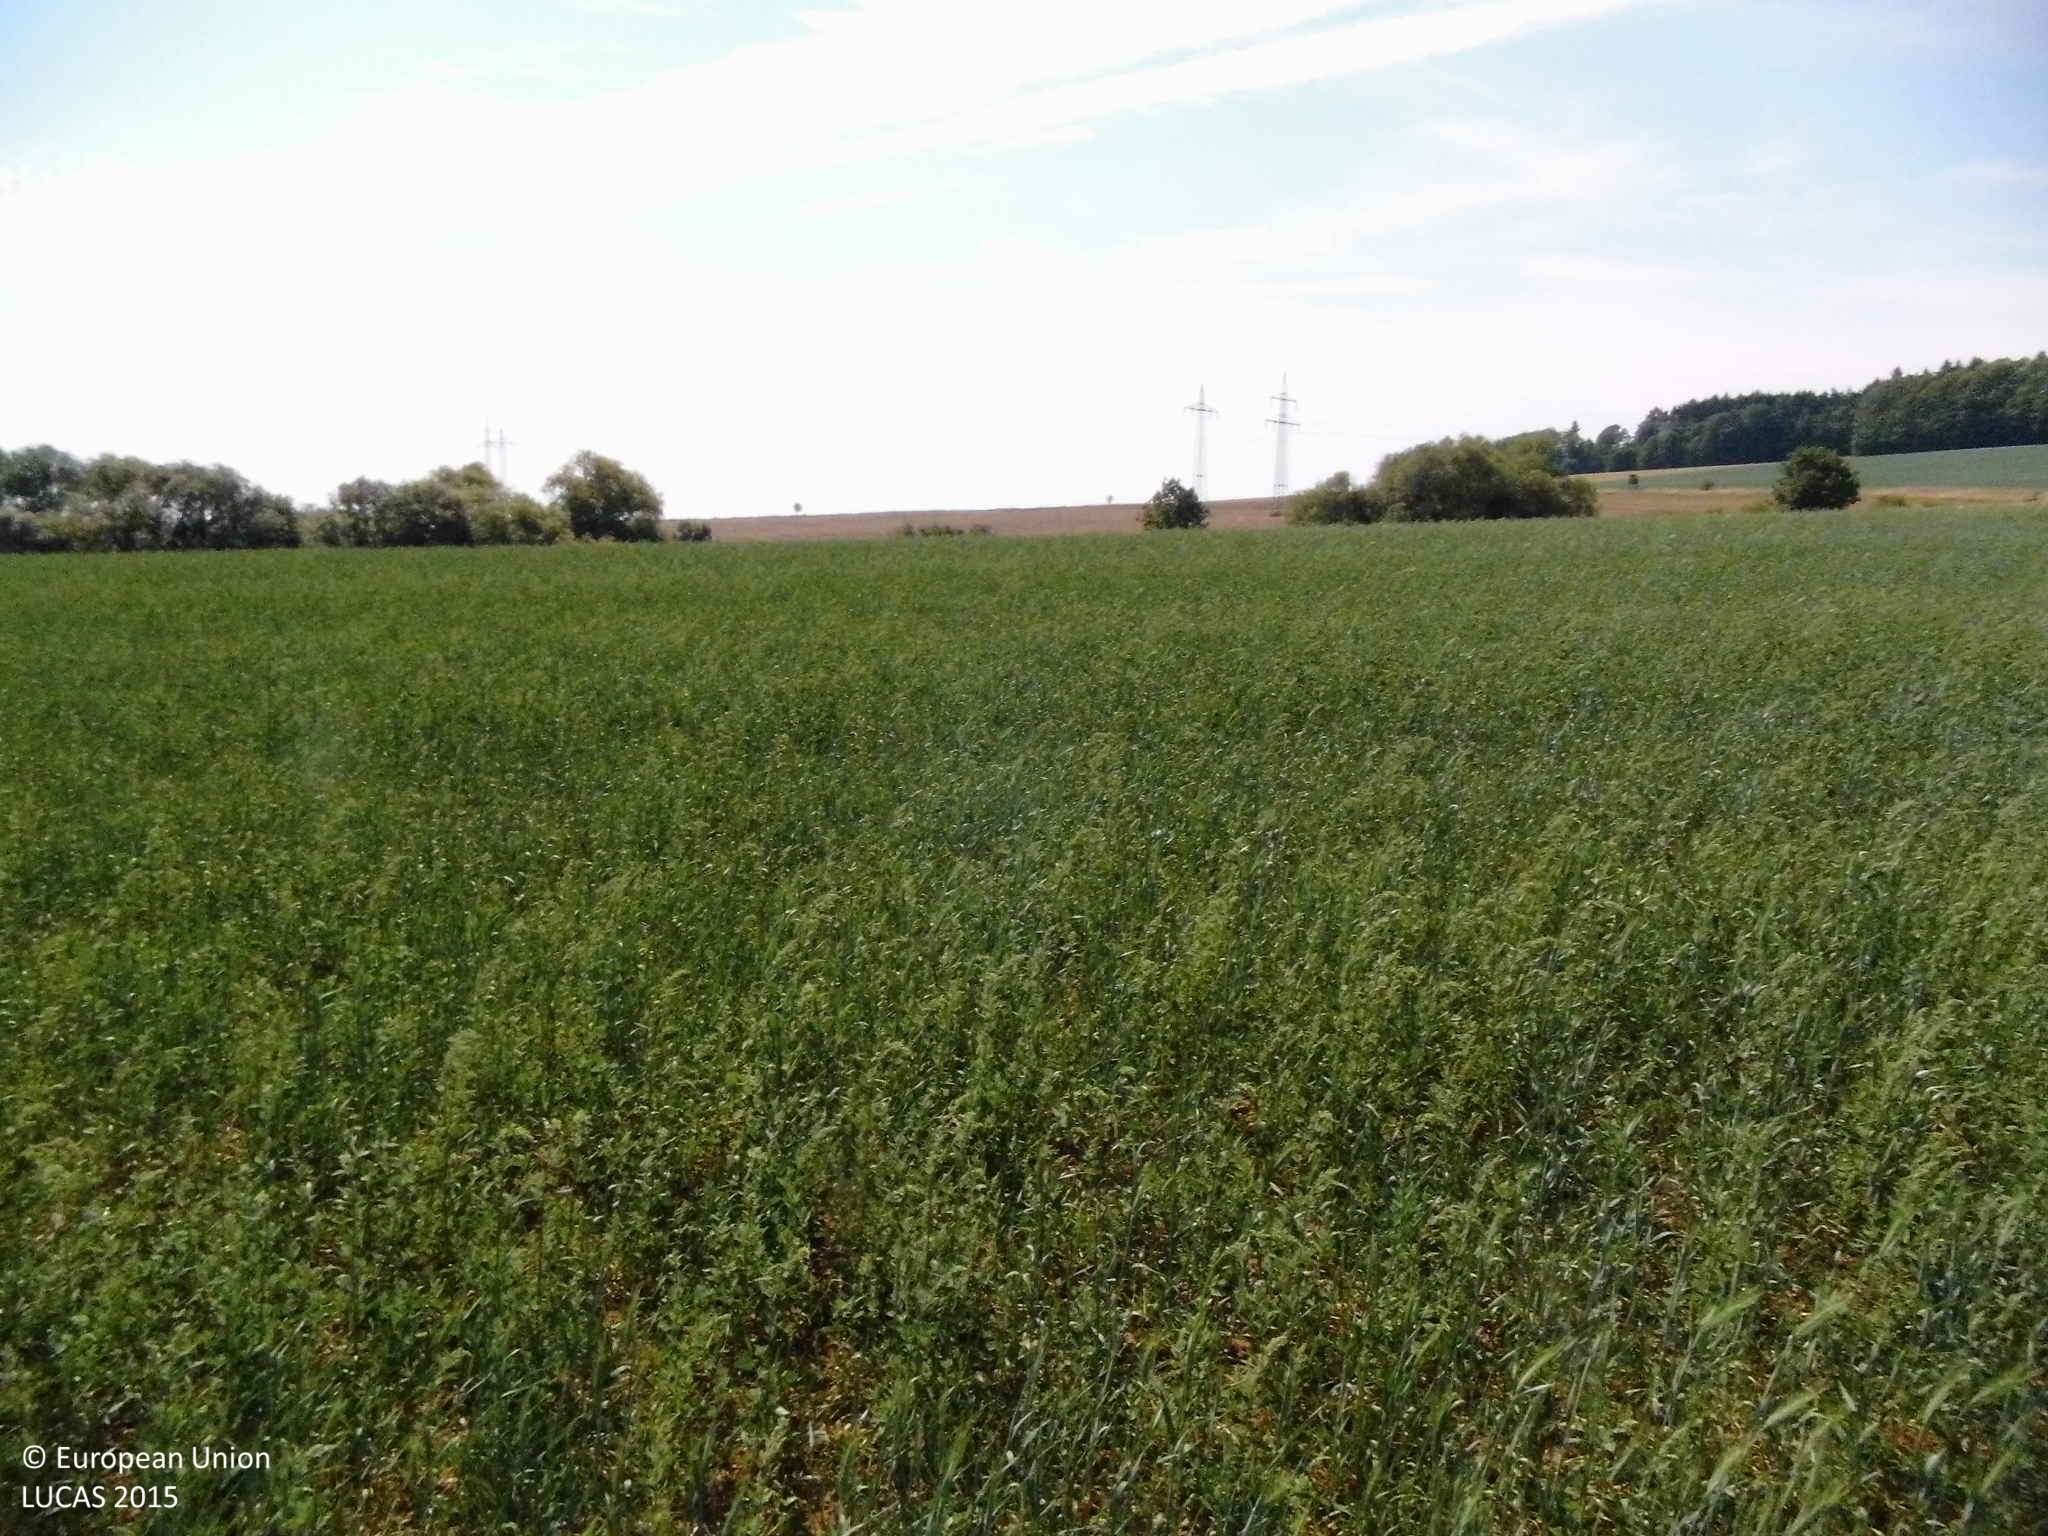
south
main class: Cropland
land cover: Rye
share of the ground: 25 - 50 %
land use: Agriculture (excluding fallow land and kitchen gardens)
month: August
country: DE
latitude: 50.4368
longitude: 8.0152
